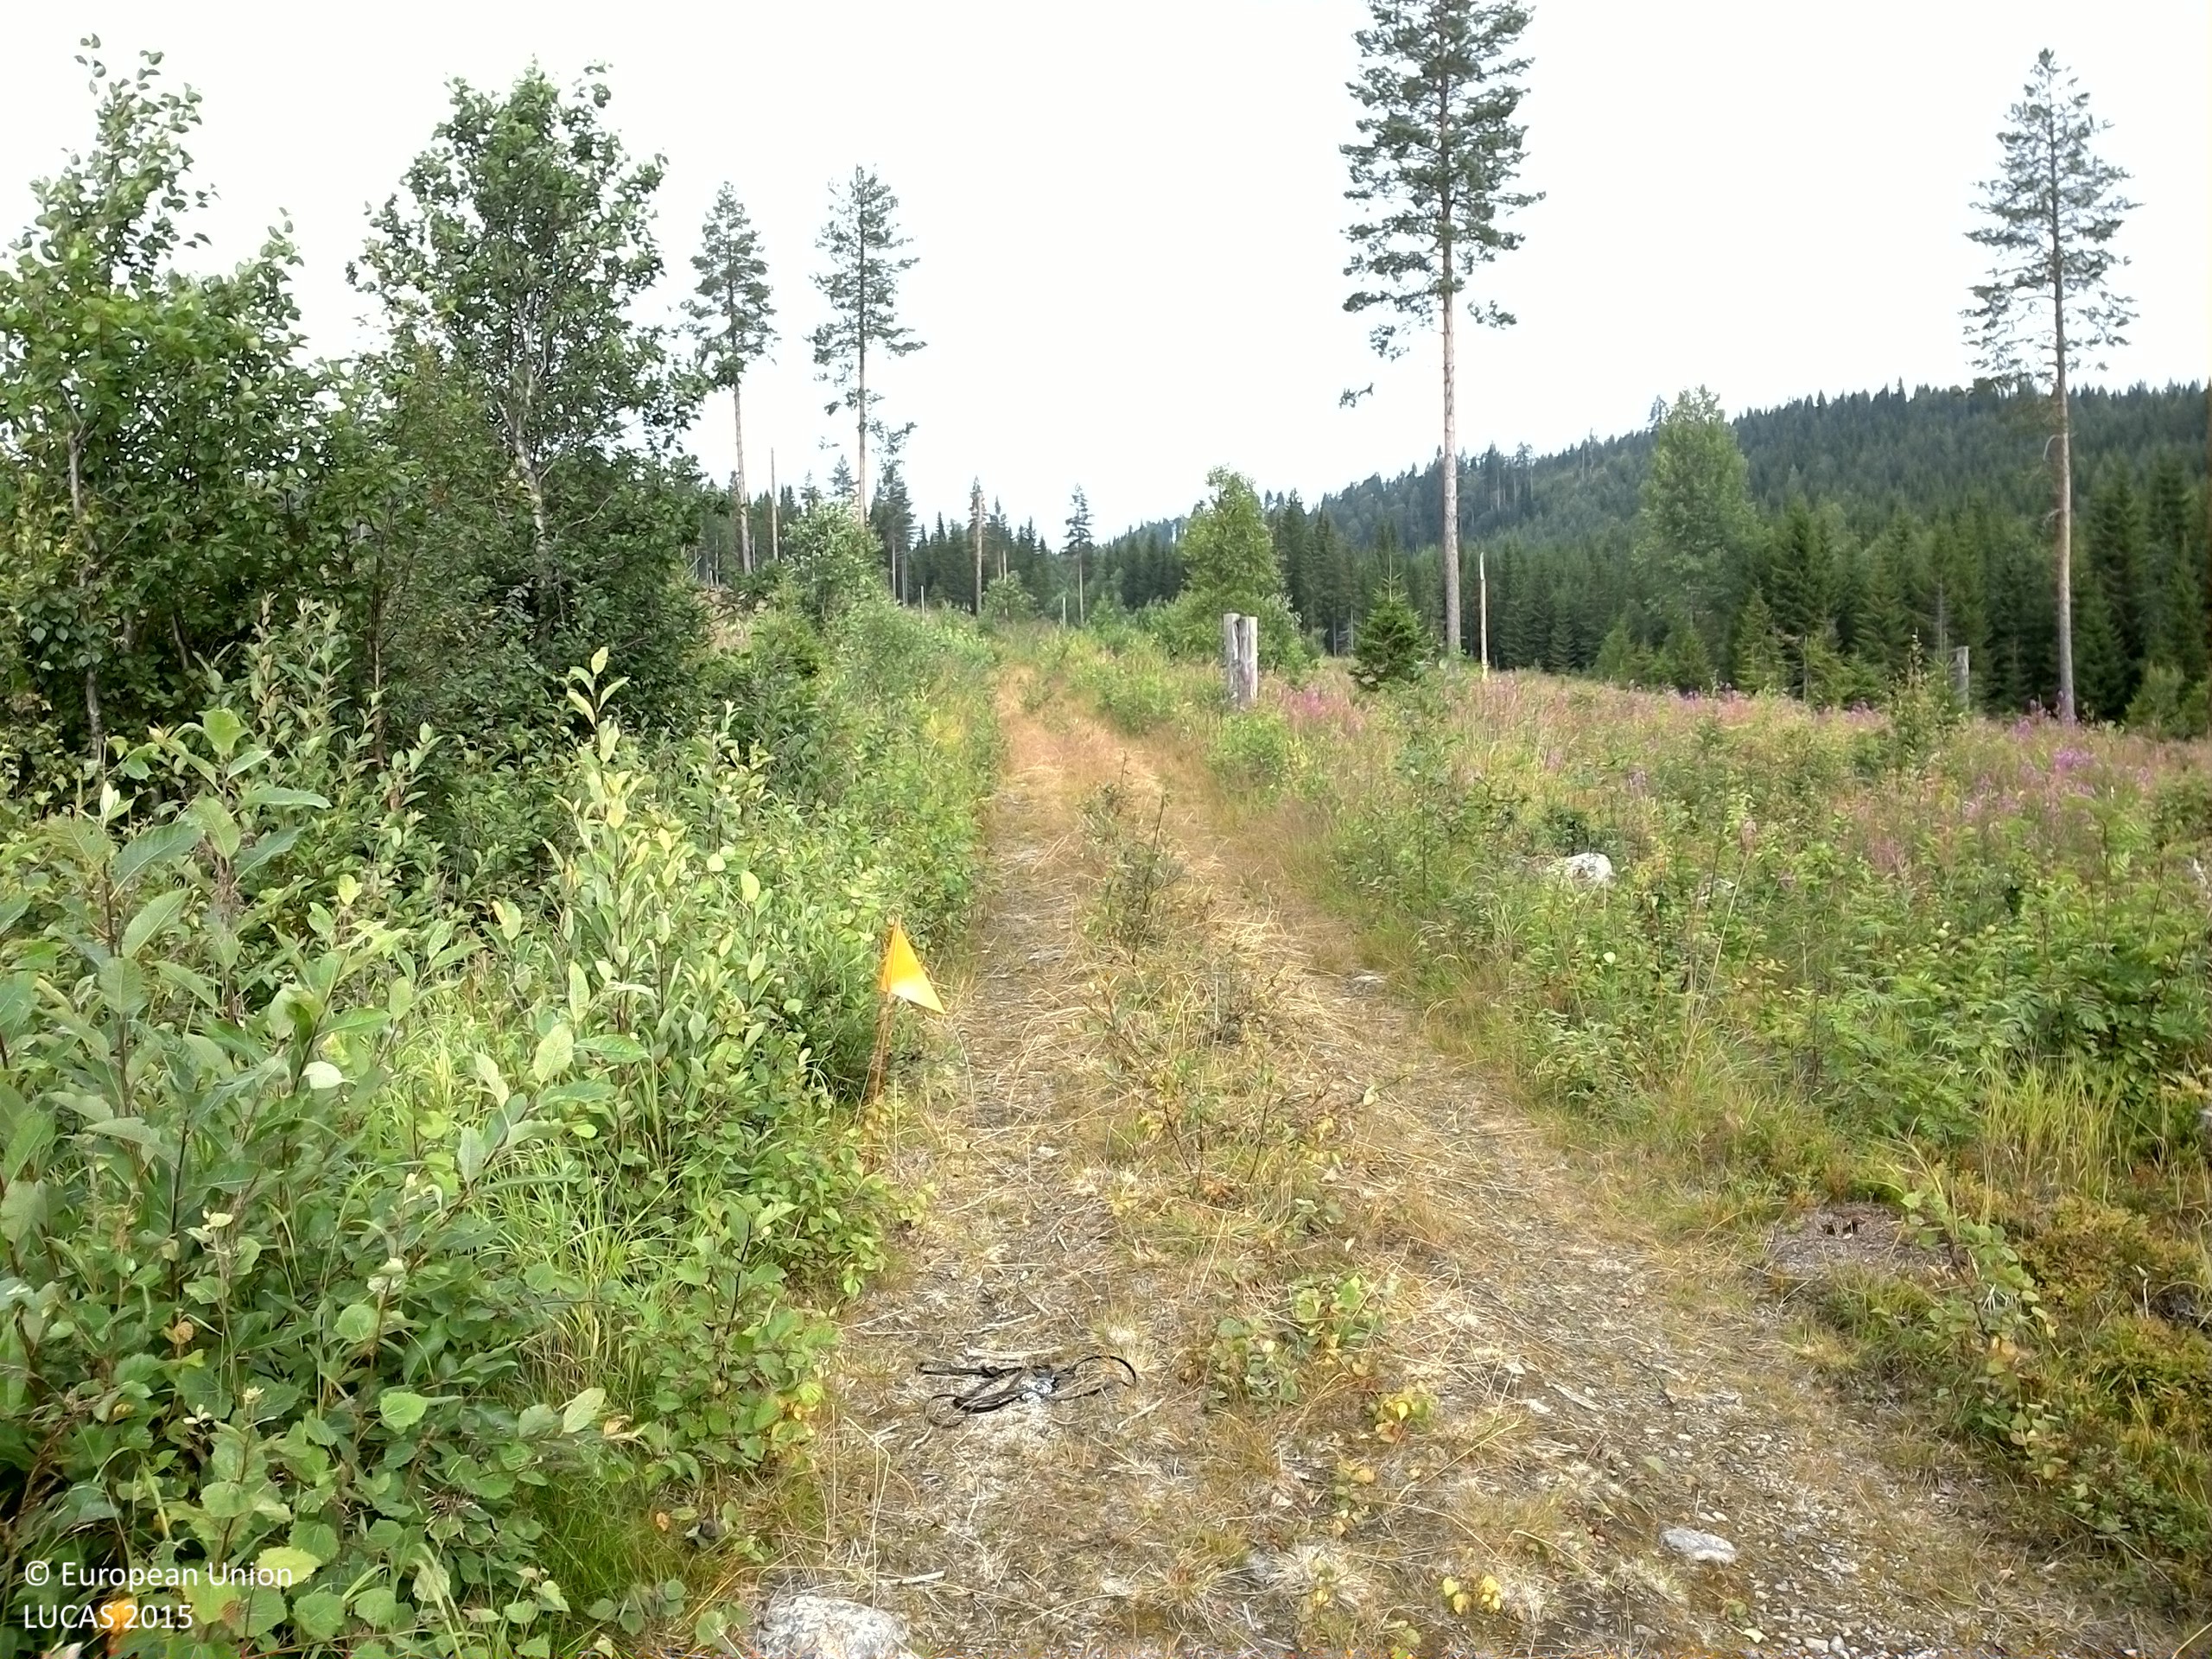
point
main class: Artificial land
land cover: Non built-up linear features
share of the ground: > 75 %
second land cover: Spontaneously vegetated surfaces
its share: 25 - 50 %
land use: Road transport
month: August
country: SE
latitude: 63.5879
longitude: 18.1754
